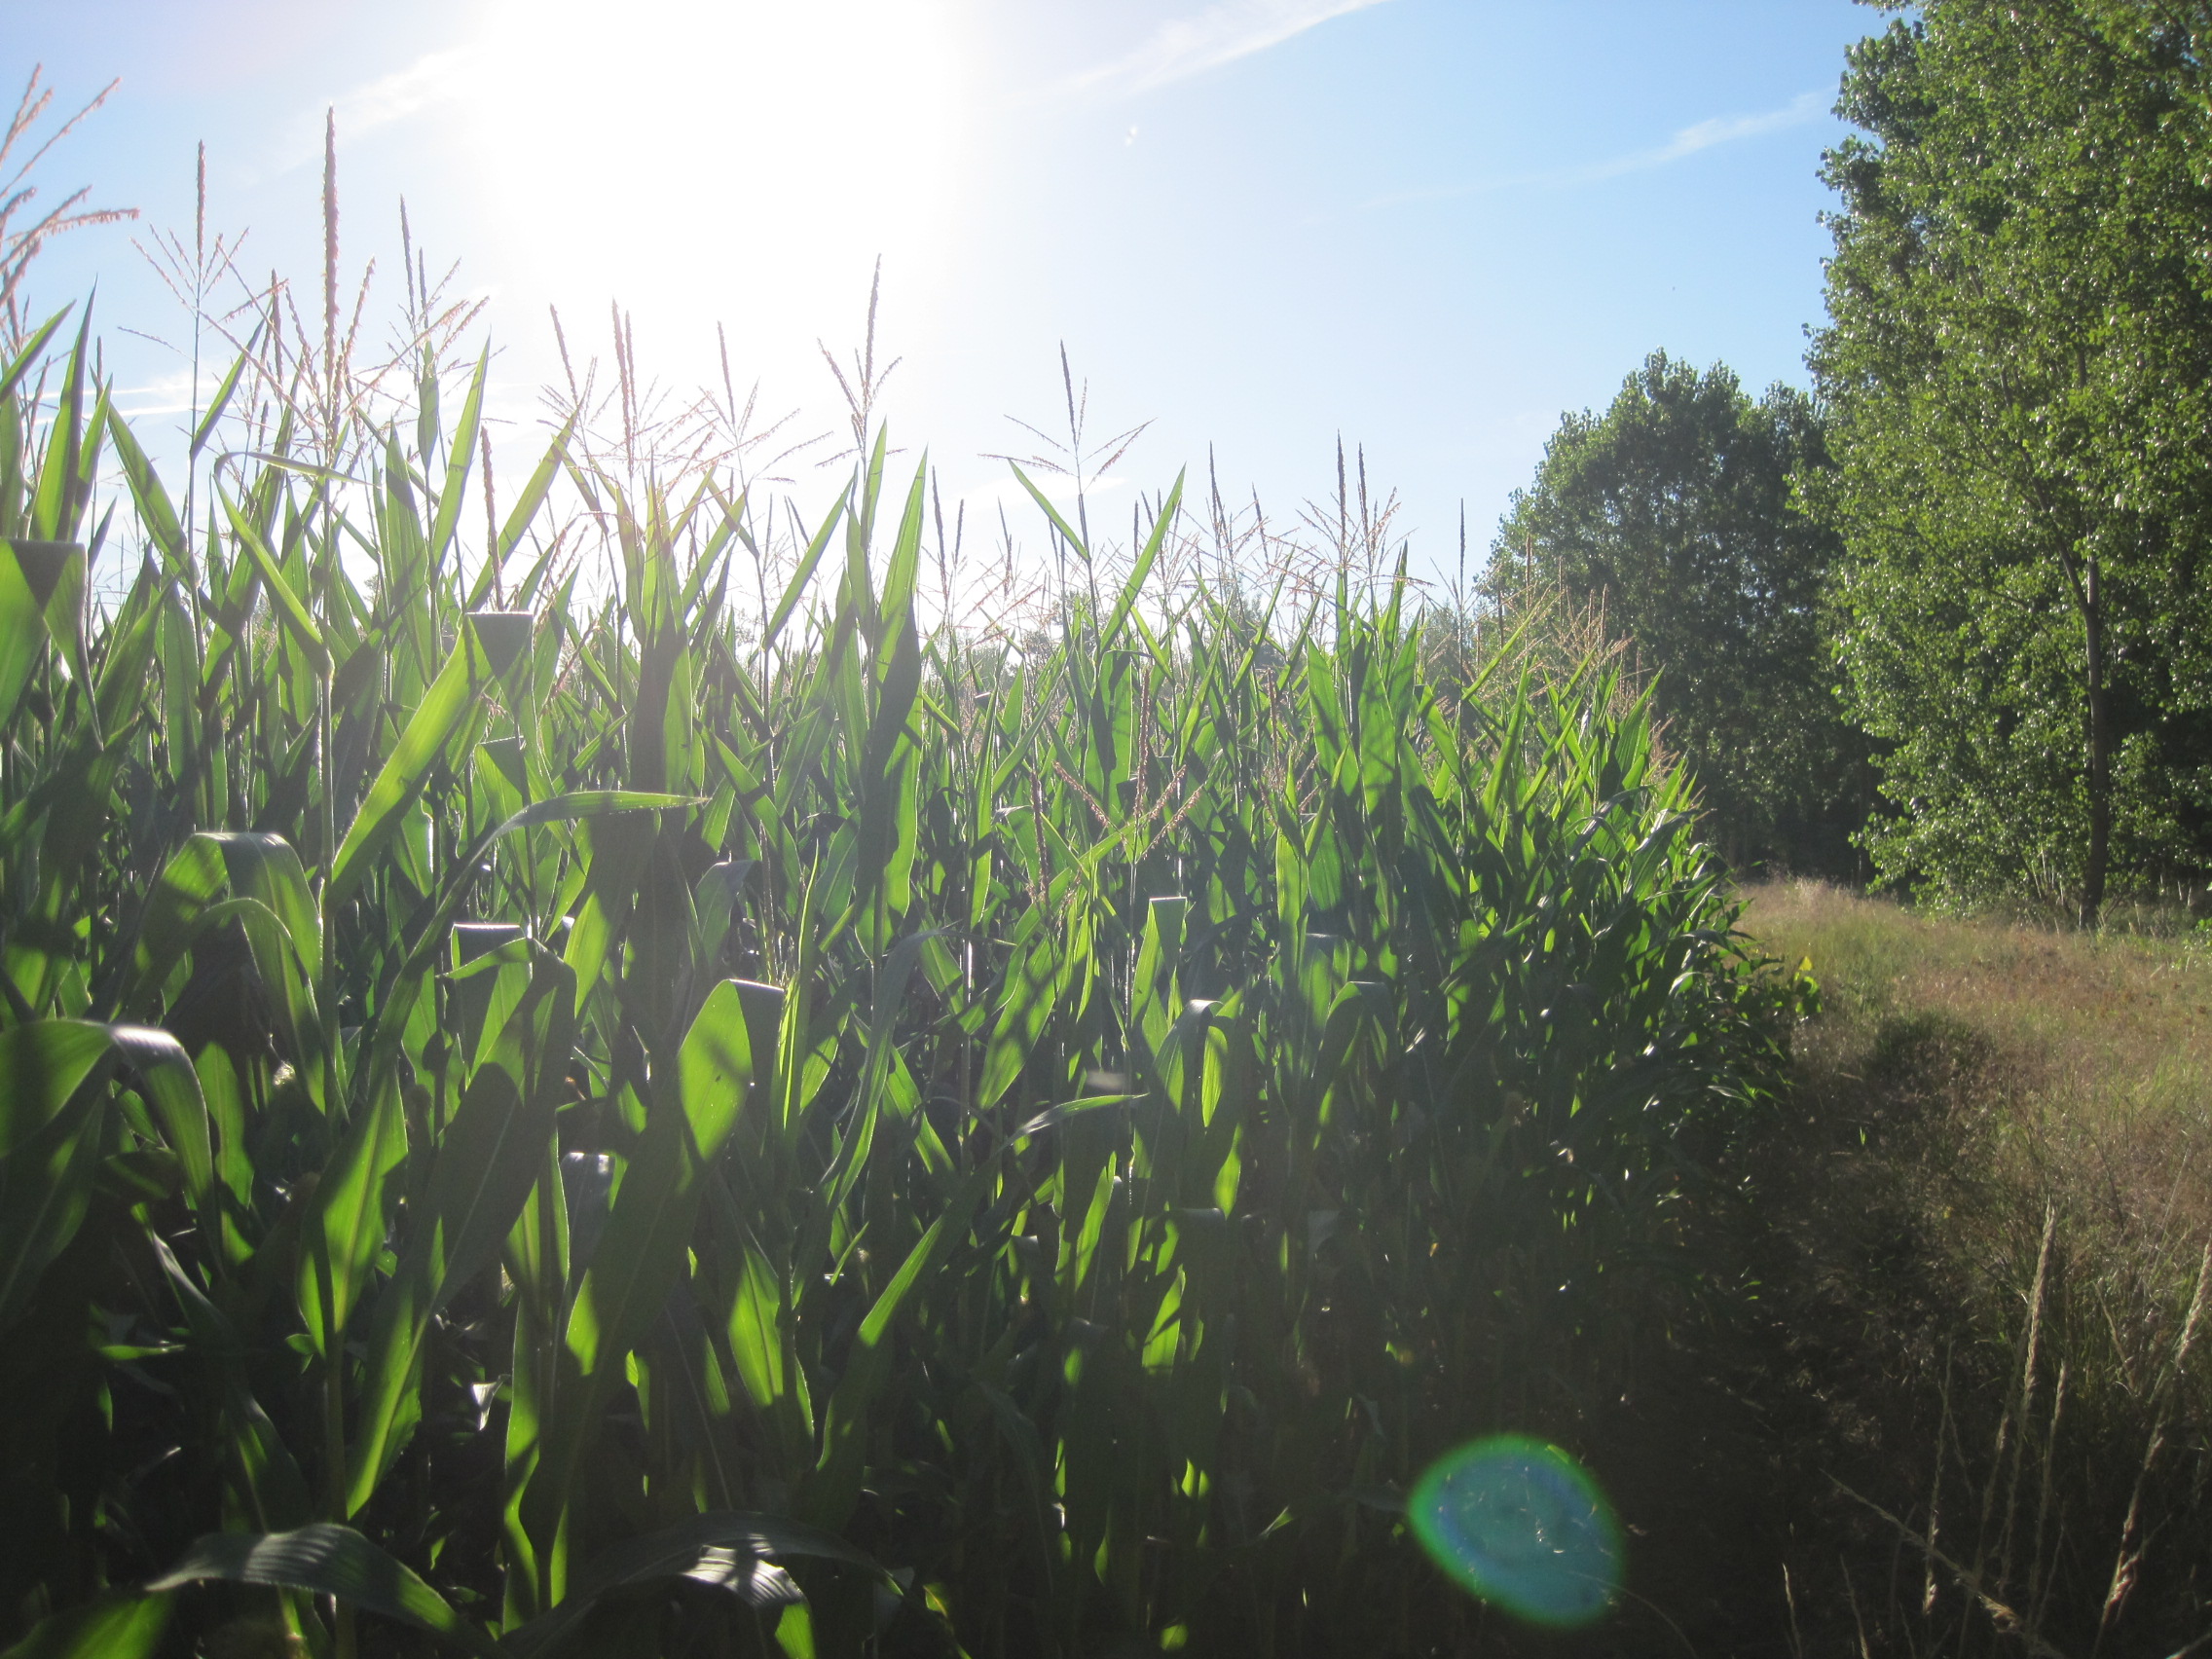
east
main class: Cropland
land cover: Maize
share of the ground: > 75 %
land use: Agriculture (excluding fallow land and kitchen gardens)
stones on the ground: < 10 %
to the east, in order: Maize; Spontaneously vegetated surfaces; Common wheat; Grass margins; Tracks; Grass margins; Broadleaved woodland
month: July
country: ES
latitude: 42.0050
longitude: -5.6051
